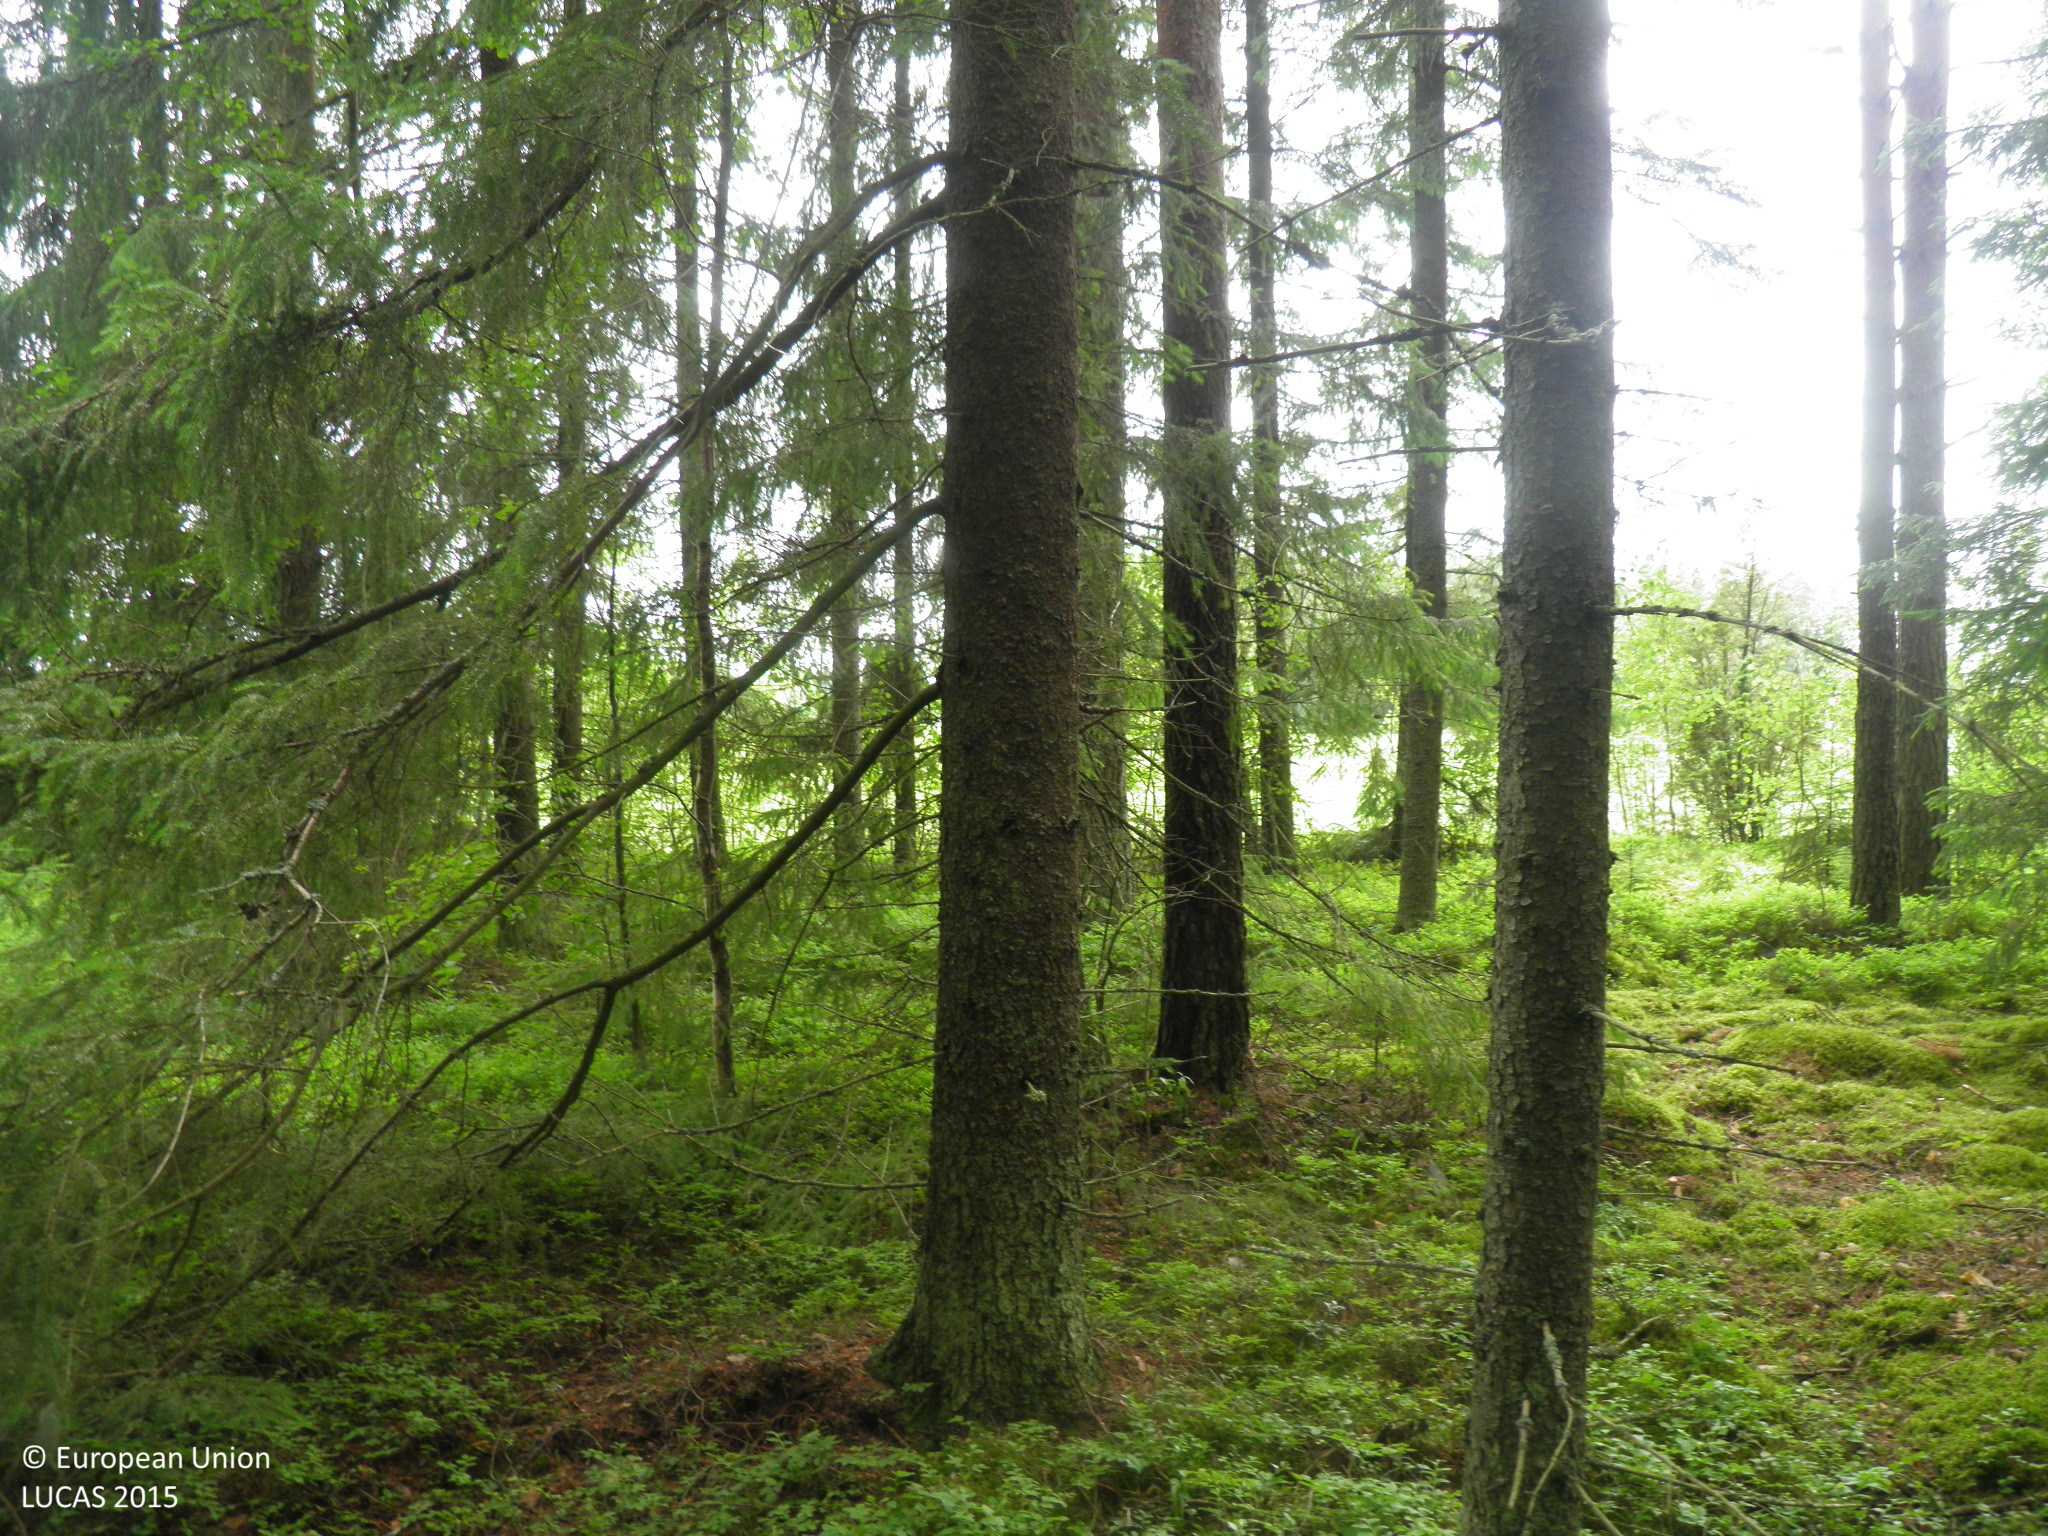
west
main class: Woodland
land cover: Spruce dominated coniferous woodland
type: boreal forest
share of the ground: > 75 %
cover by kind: coniferous forest trees 60 %, broadleaved forest trees 15 %, shrubs 15 %, lichens and mosses 10 %
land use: Forestry
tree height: > 5 m
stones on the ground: < 10 %
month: July
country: FI
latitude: 60.7054
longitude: 22.8442
